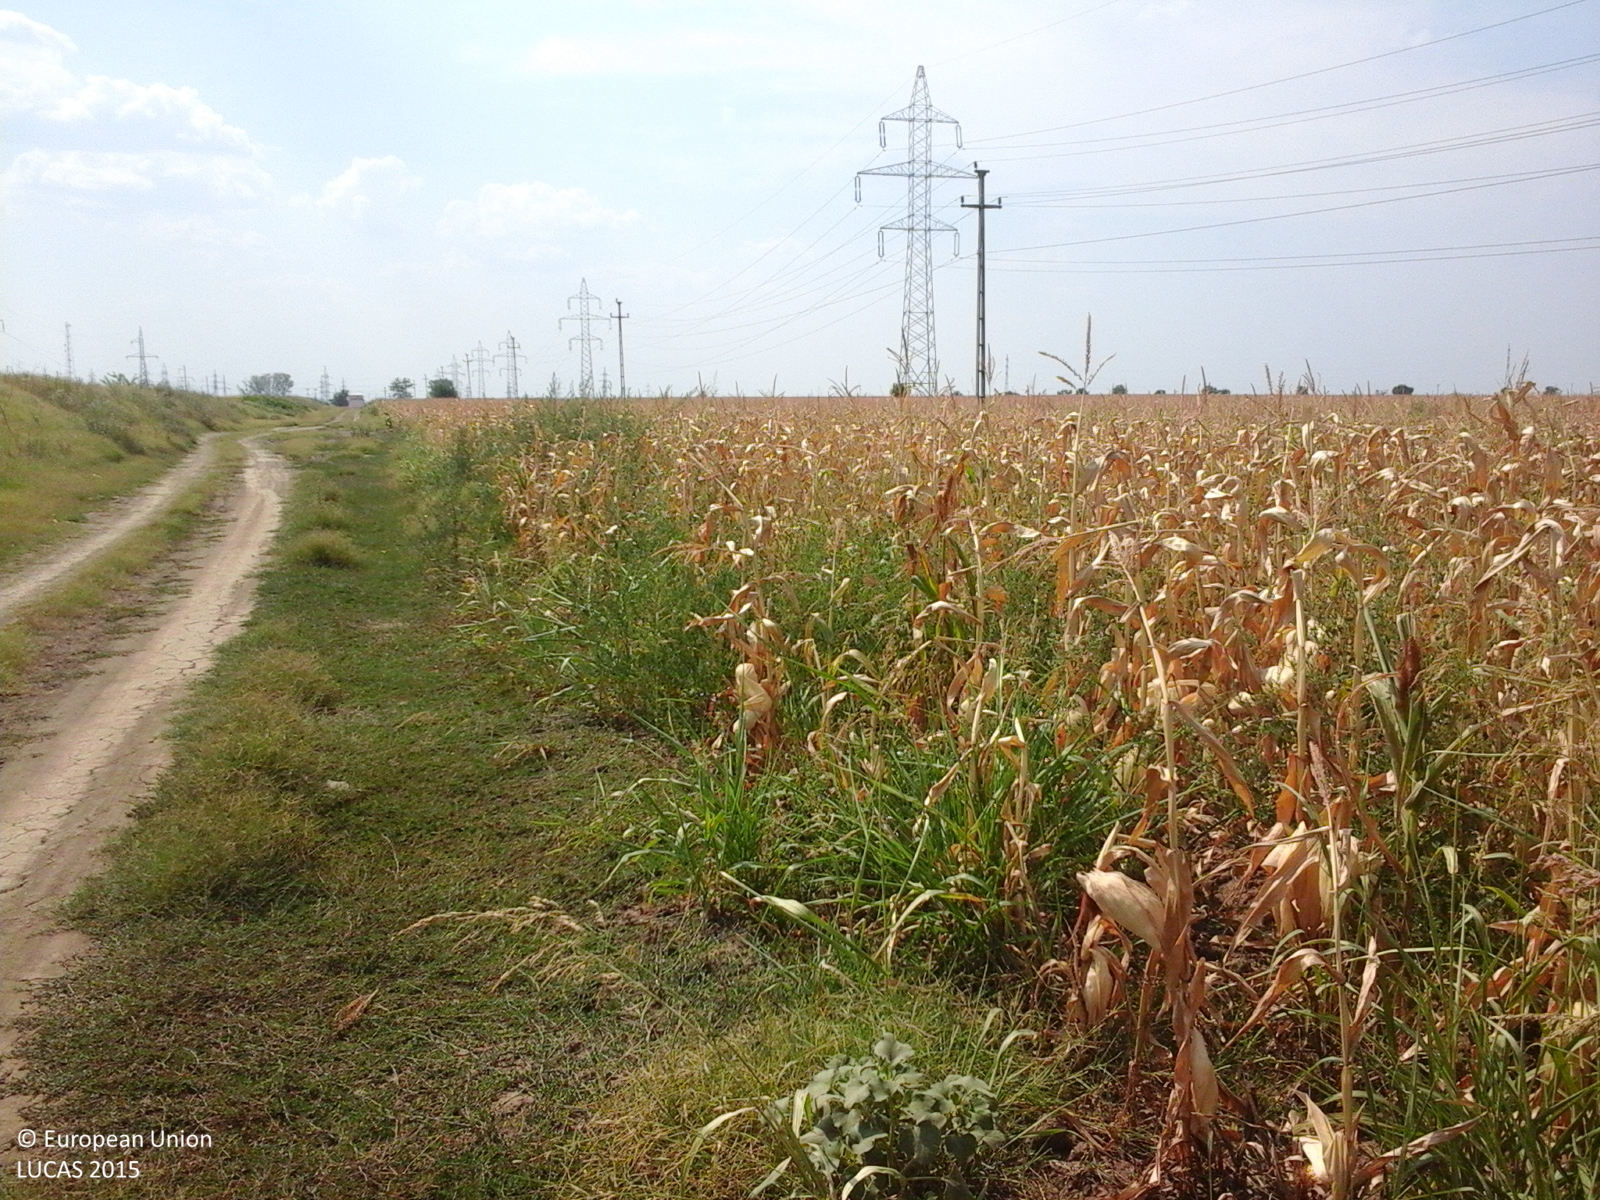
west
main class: Cropland
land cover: Maize
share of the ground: > 75 %
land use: Agriculture (excluding fallow land and kitchen gardens)
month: August
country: RO
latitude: 44.1213
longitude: 23.0773
